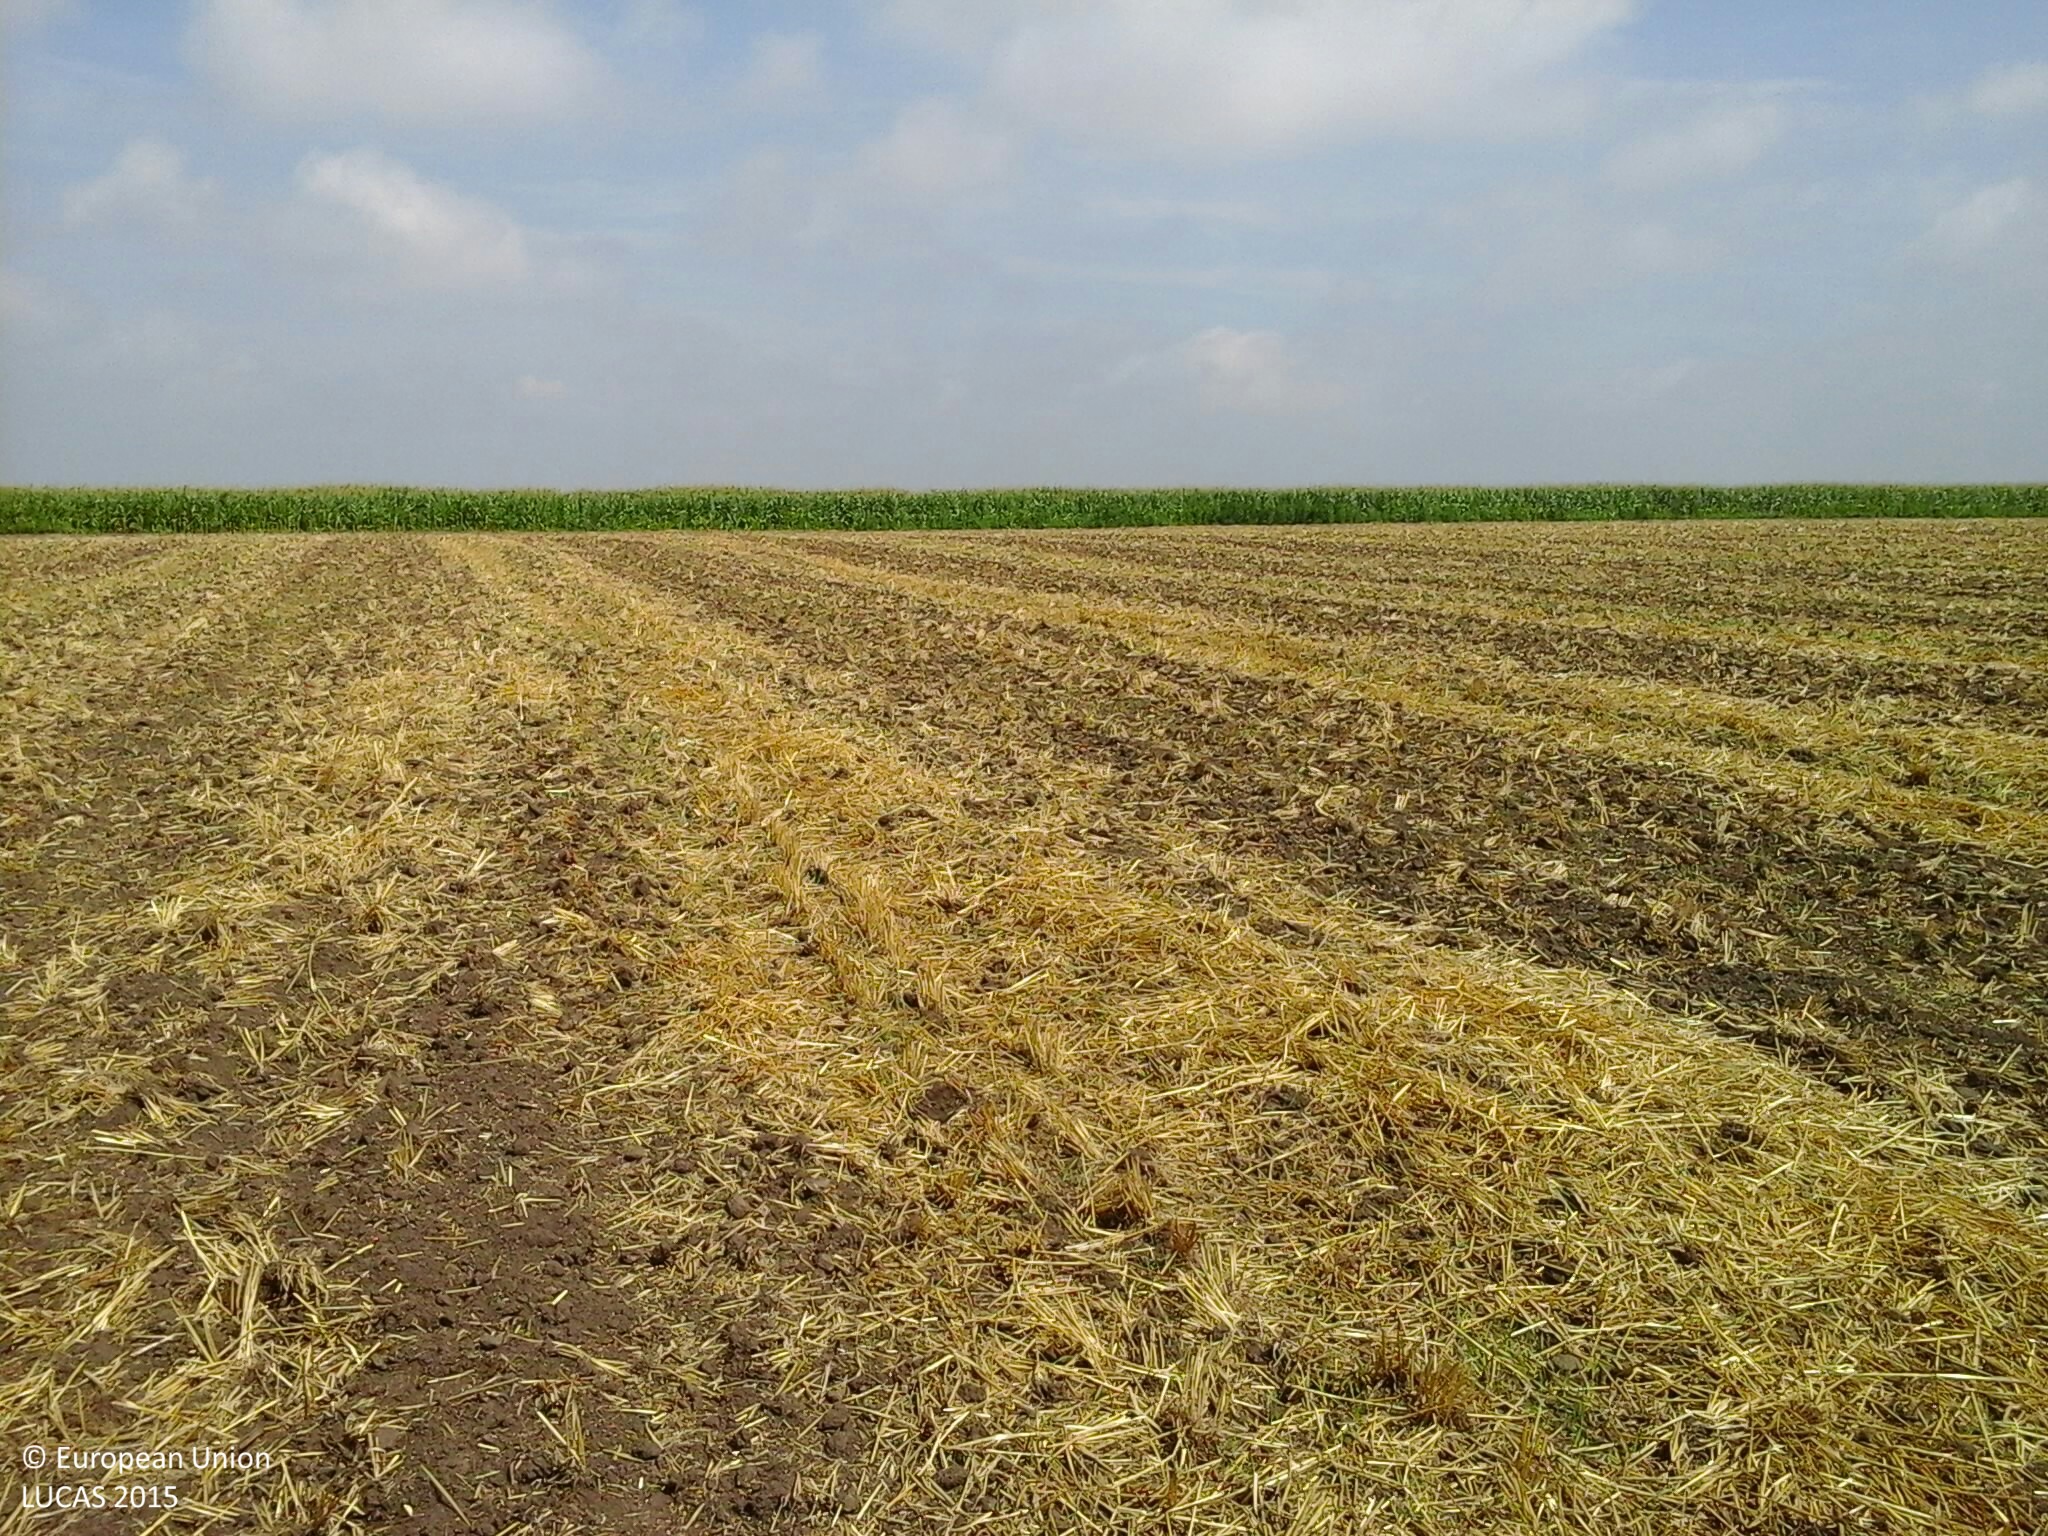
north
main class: Cropland
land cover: Common wheat
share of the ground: 10 - 25 %
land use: Agriculture (excluding fallow land and kitchen gardens)
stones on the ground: < 10 %
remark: Harvested field
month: July
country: HU
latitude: 47.9119
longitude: 21.4843
